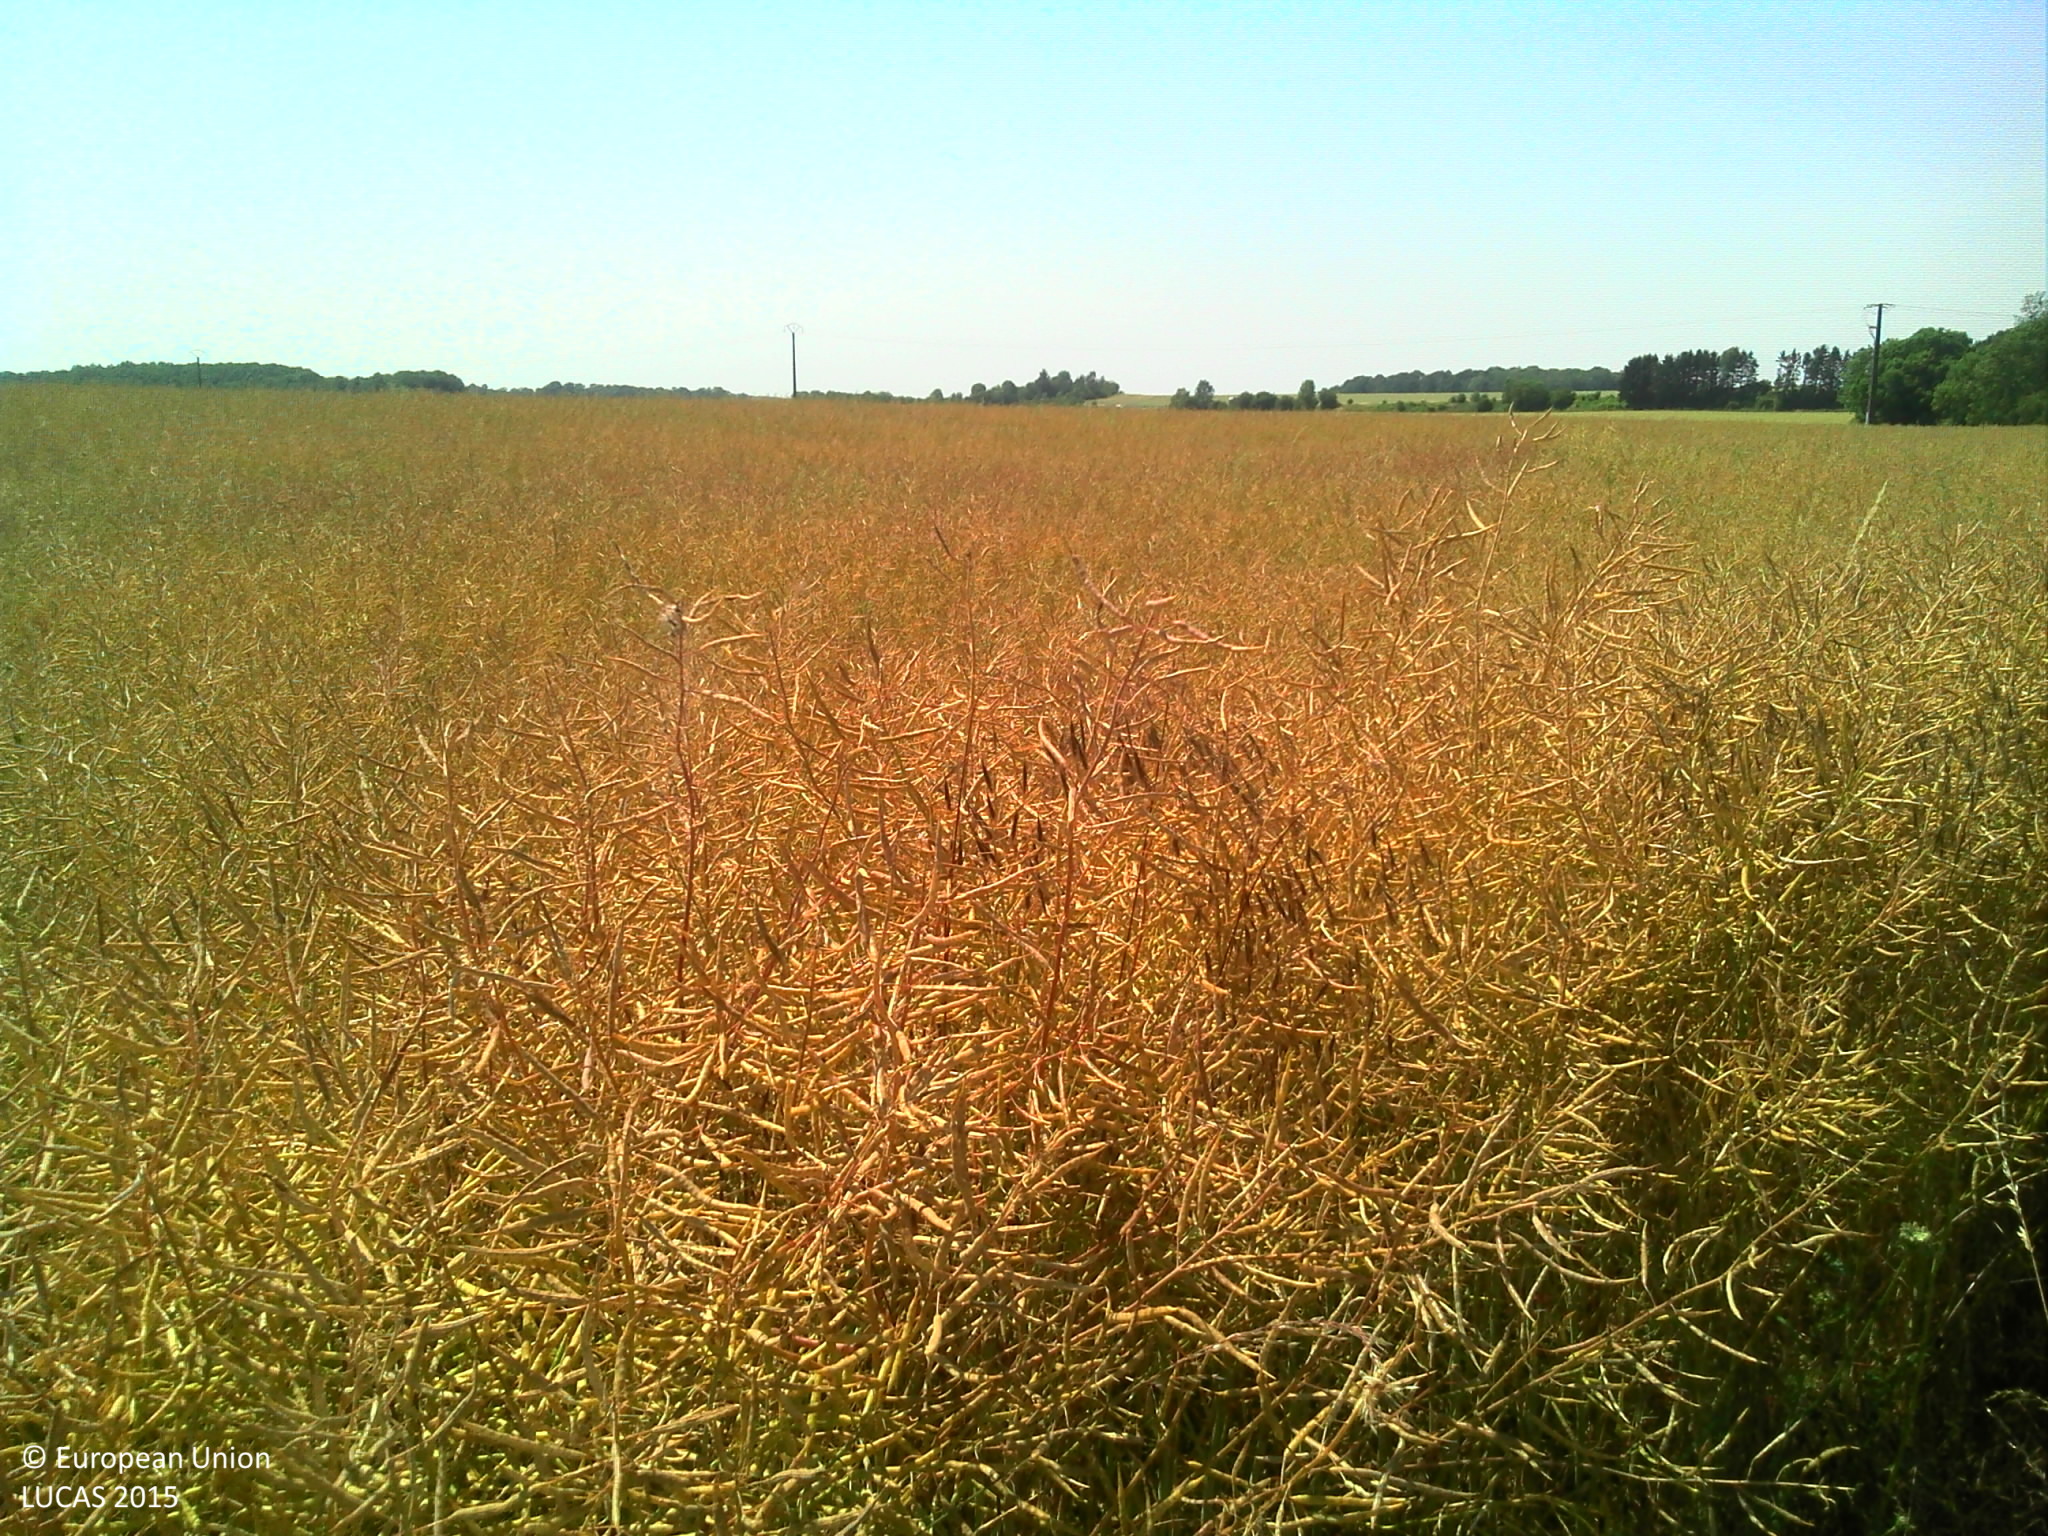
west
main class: Cropland
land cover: Rape and turnip rape
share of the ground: > 75 %
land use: Agriculture (excluding fallow land and kitchen gardens)
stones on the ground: < 10 %
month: July
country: FR
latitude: 49.0699
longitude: 3.3539
